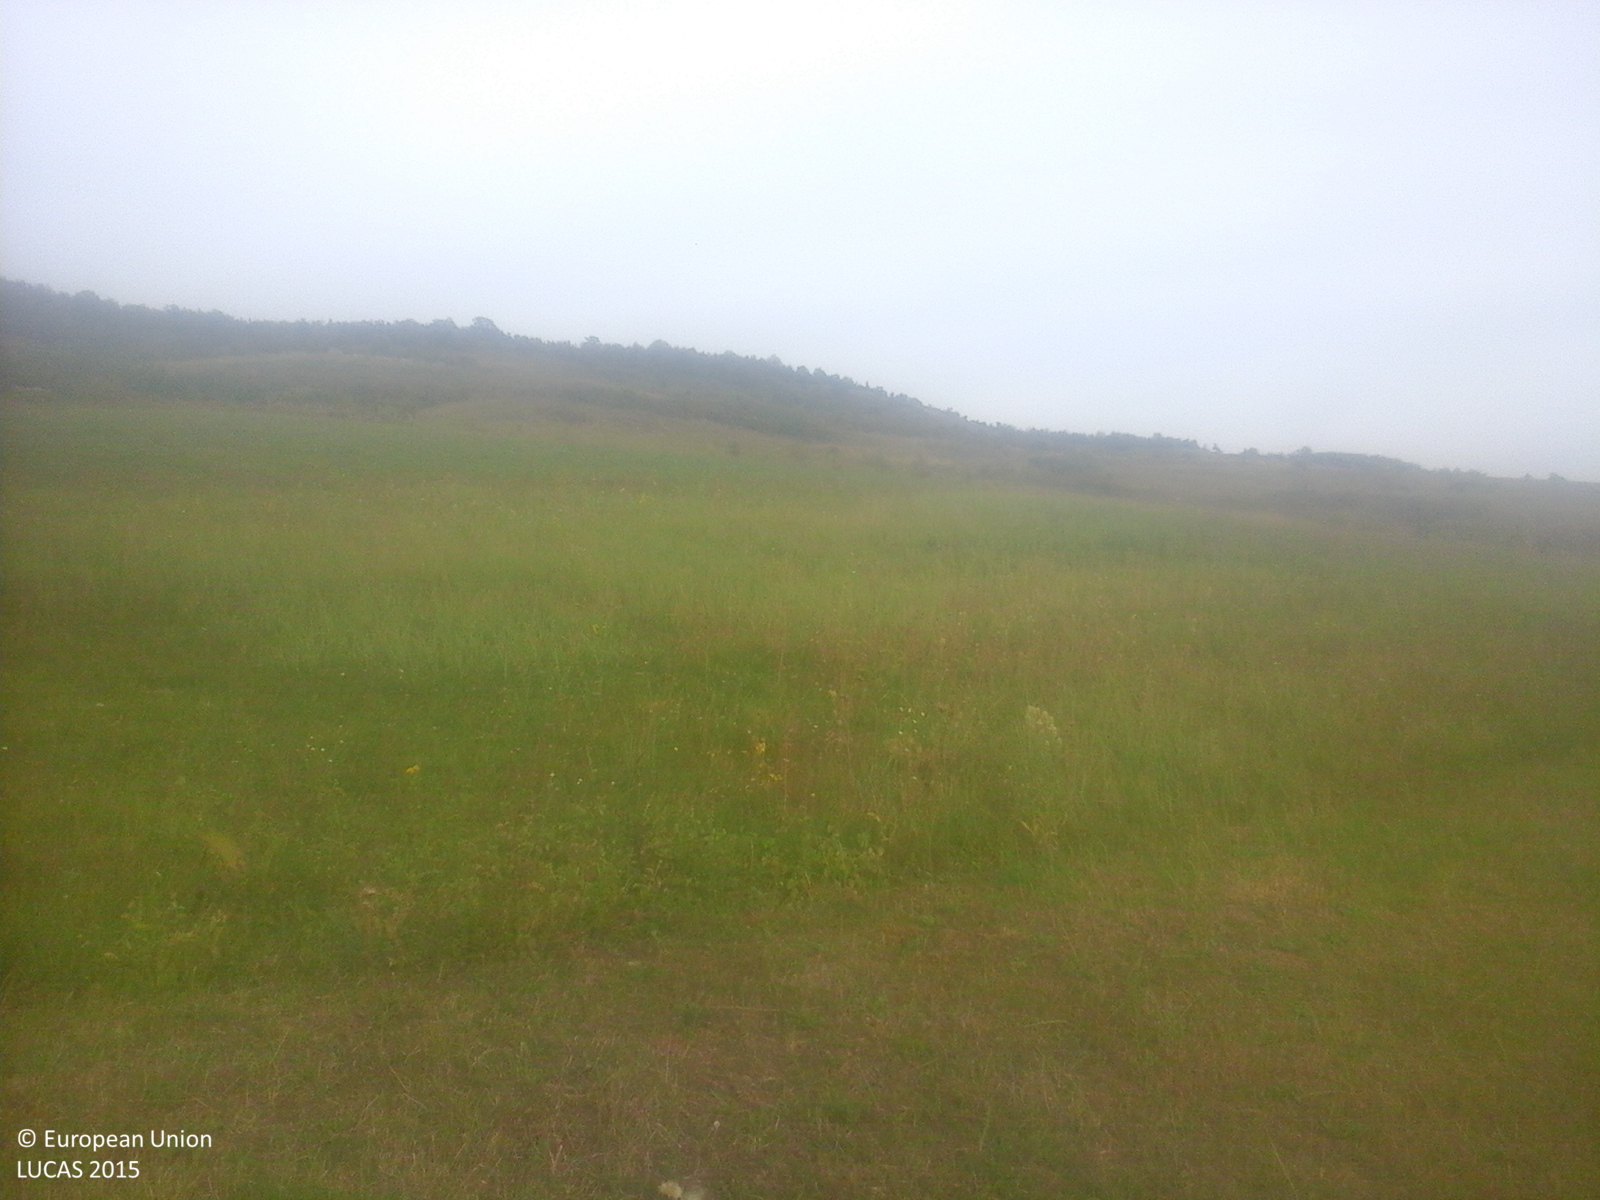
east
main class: Grassland
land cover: Grassland without tree/shrub cover
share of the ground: > 75 %
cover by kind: herbaceous plants 100 %
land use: Agriculture (excluding fallow land and kitchen gardens)
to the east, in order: Grassland without tree/shrub cover; Lucerne; Spontaneously vegetated surfaces; Grassland with sparse tree/shrub cover; Tracks; Grassland with sparse tree/shrub cover; Shrubland with sparse tree cover; Grassland without tree/shrub cover
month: September
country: RO
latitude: 46.9542
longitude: 24.4508
